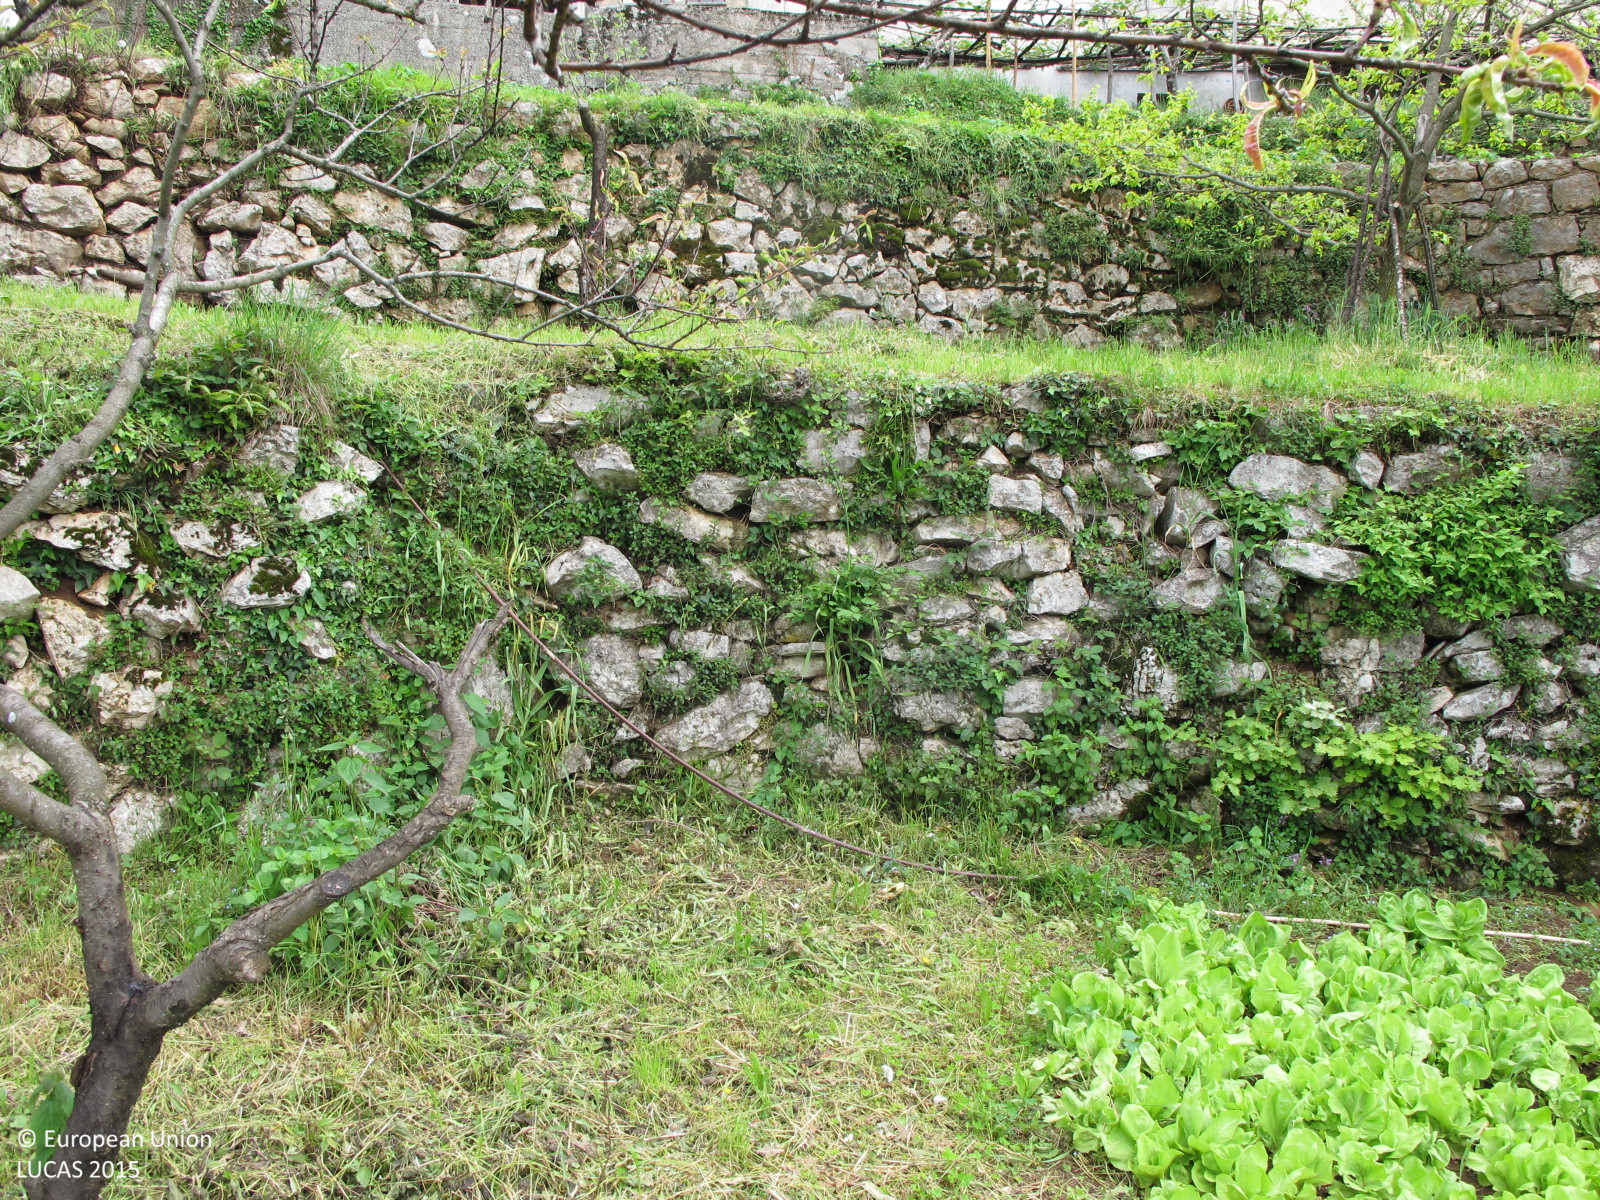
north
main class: Cropland
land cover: Other fresh vegetables
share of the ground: > 75 %
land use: Kitchen garden
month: May
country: HR
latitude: 45.3279
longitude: 14.2691
